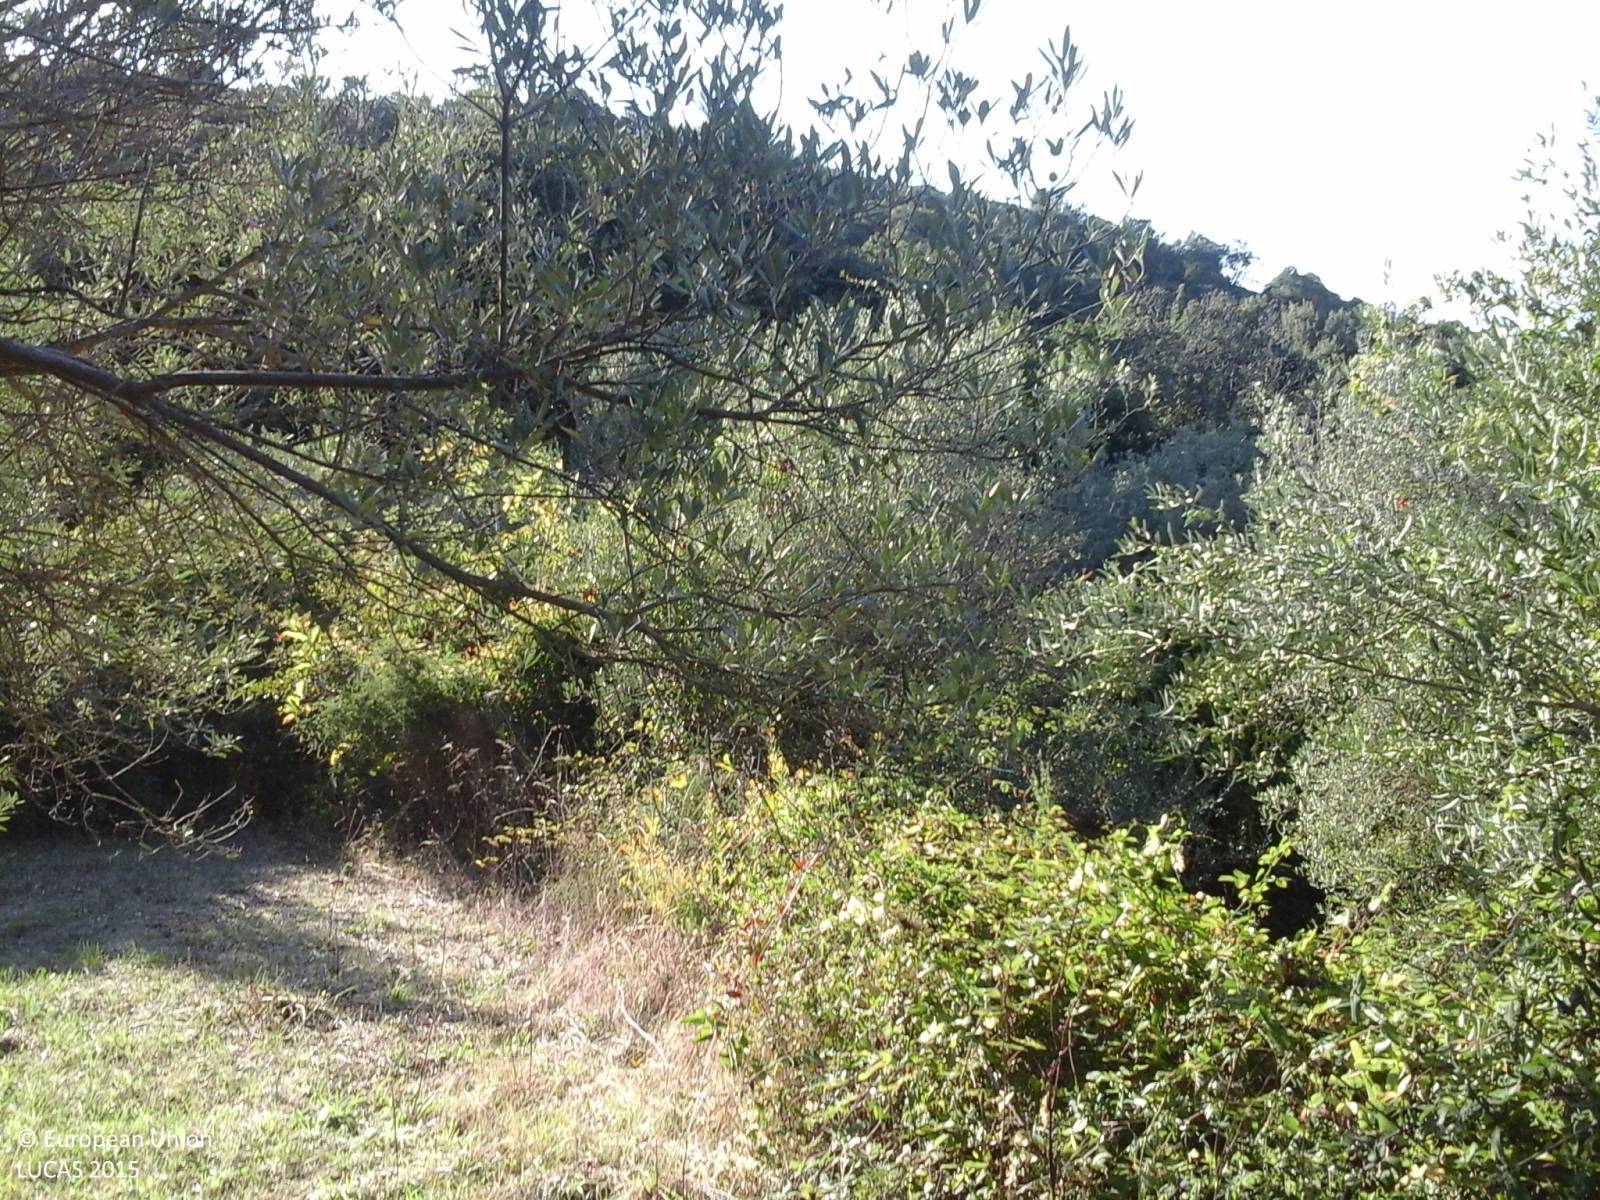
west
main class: Cropland
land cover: Olive groves
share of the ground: 25 - 50 %
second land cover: Grassland without tree/shrub cover
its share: 25 - 50 %
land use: Agriculture (excluding fallow land and kitchen gardens)
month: October
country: IT
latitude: 40.2557
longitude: 8.4912
